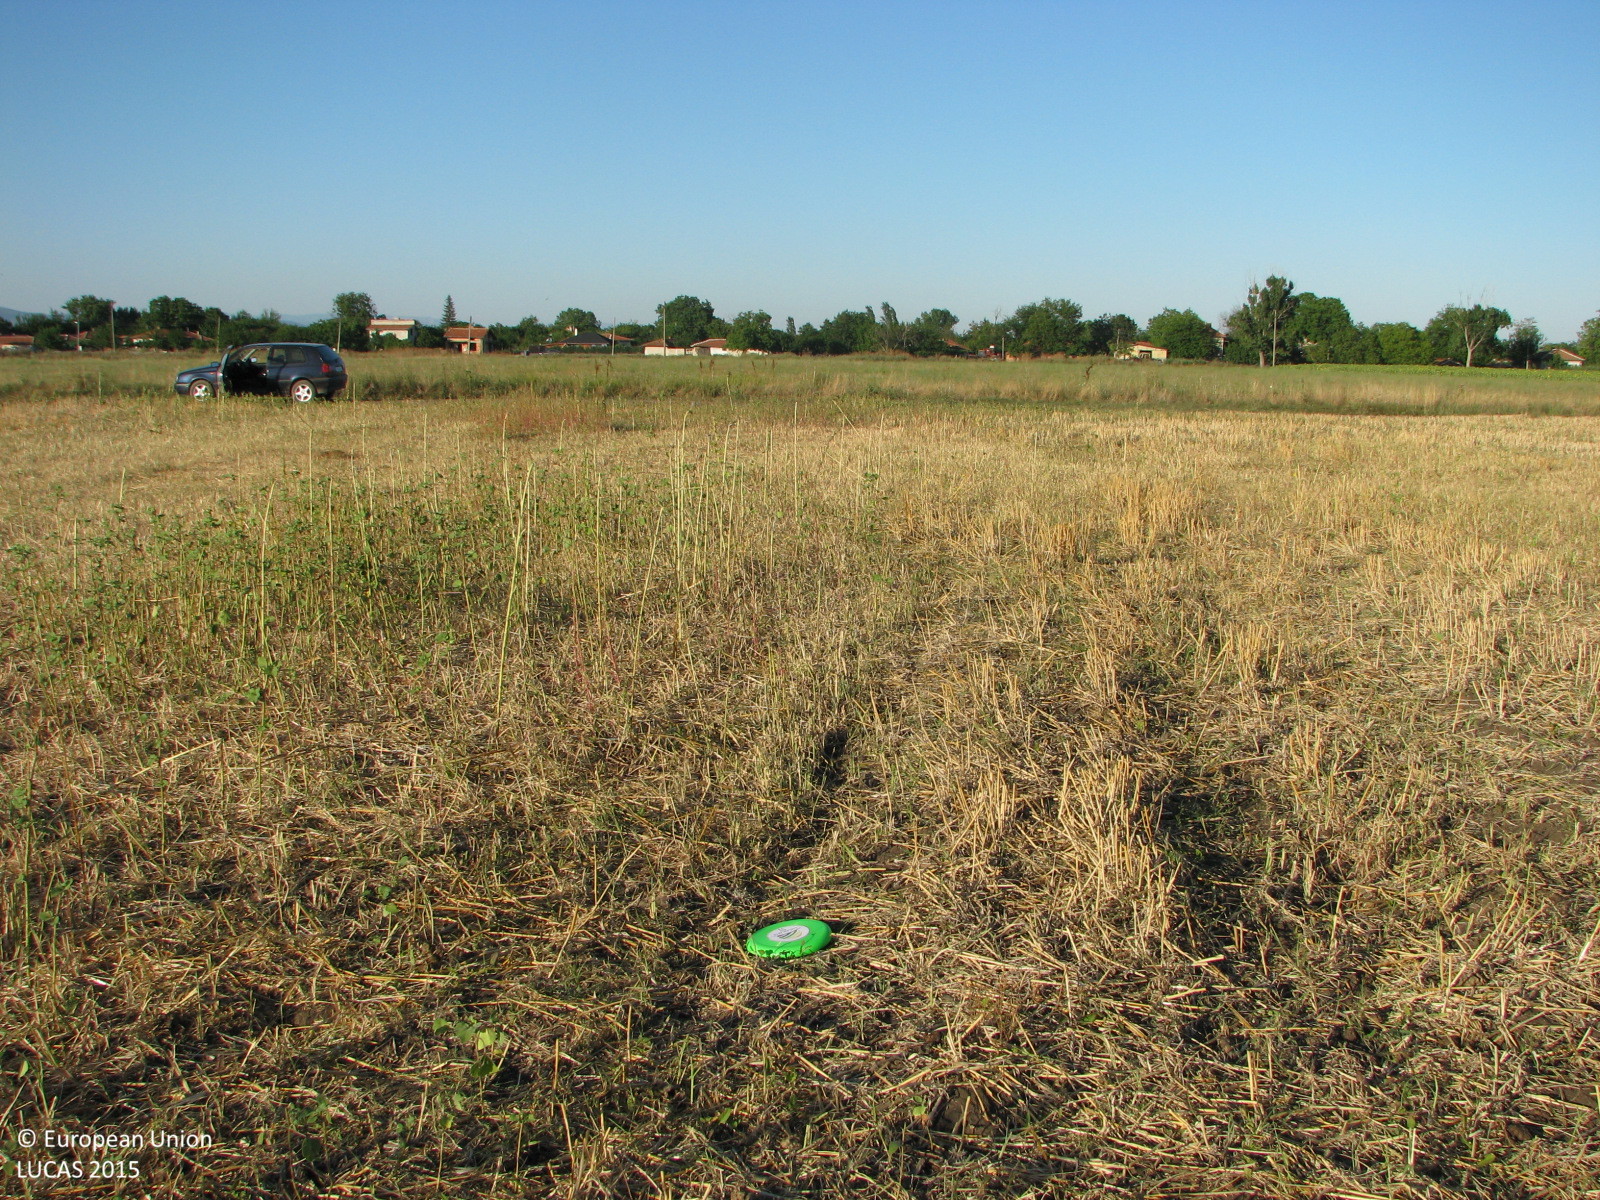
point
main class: Cropland
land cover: Common wheat
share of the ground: 10 - 25 %
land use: Agriculture (excluding fallow land and kitchen gardens)
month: July
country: BG
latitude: 42.4607
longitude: 25.9741
